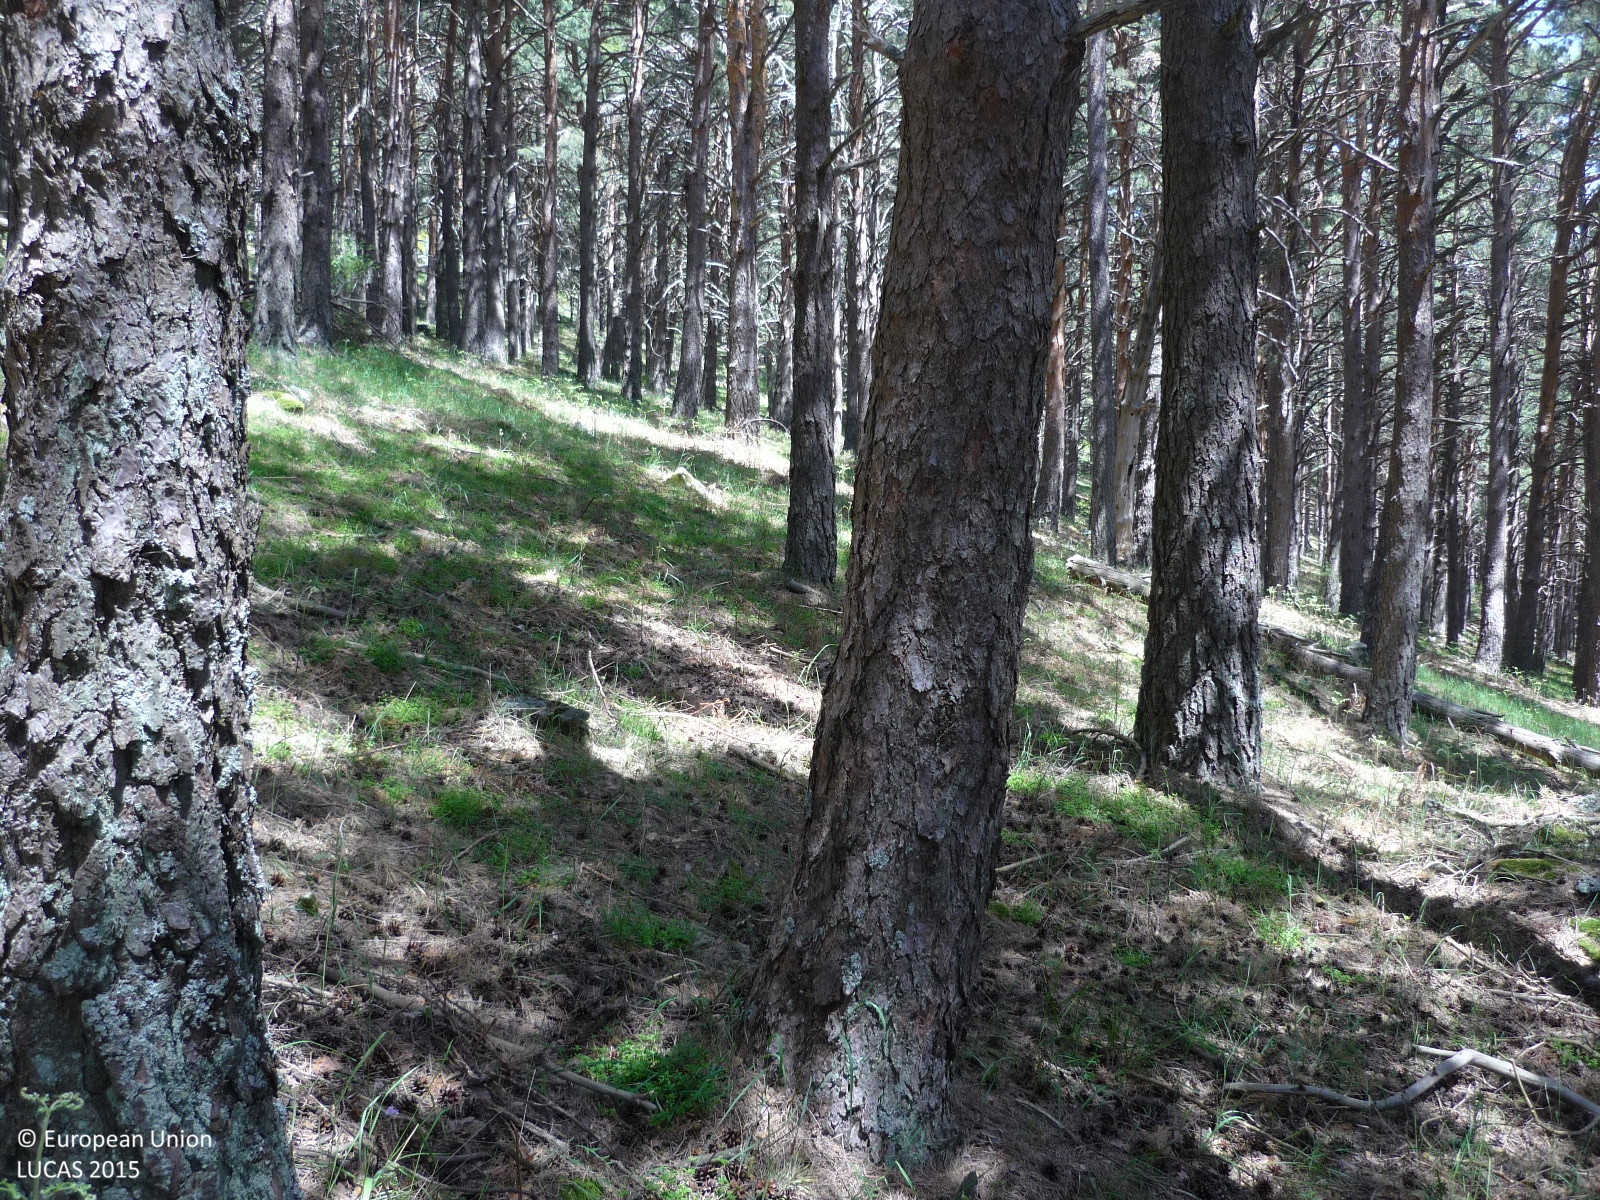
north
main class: Woodland
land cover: Pine dominated coniferous woodland
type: coniferous forest of the mediterranean region
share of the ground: > 75 %
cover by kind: coniferous forest trees 90 %, herbaceous plants 10 %
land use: Forestry
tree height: > 5 m
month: May
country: ES
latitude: 40.8066
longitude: -3.8063
